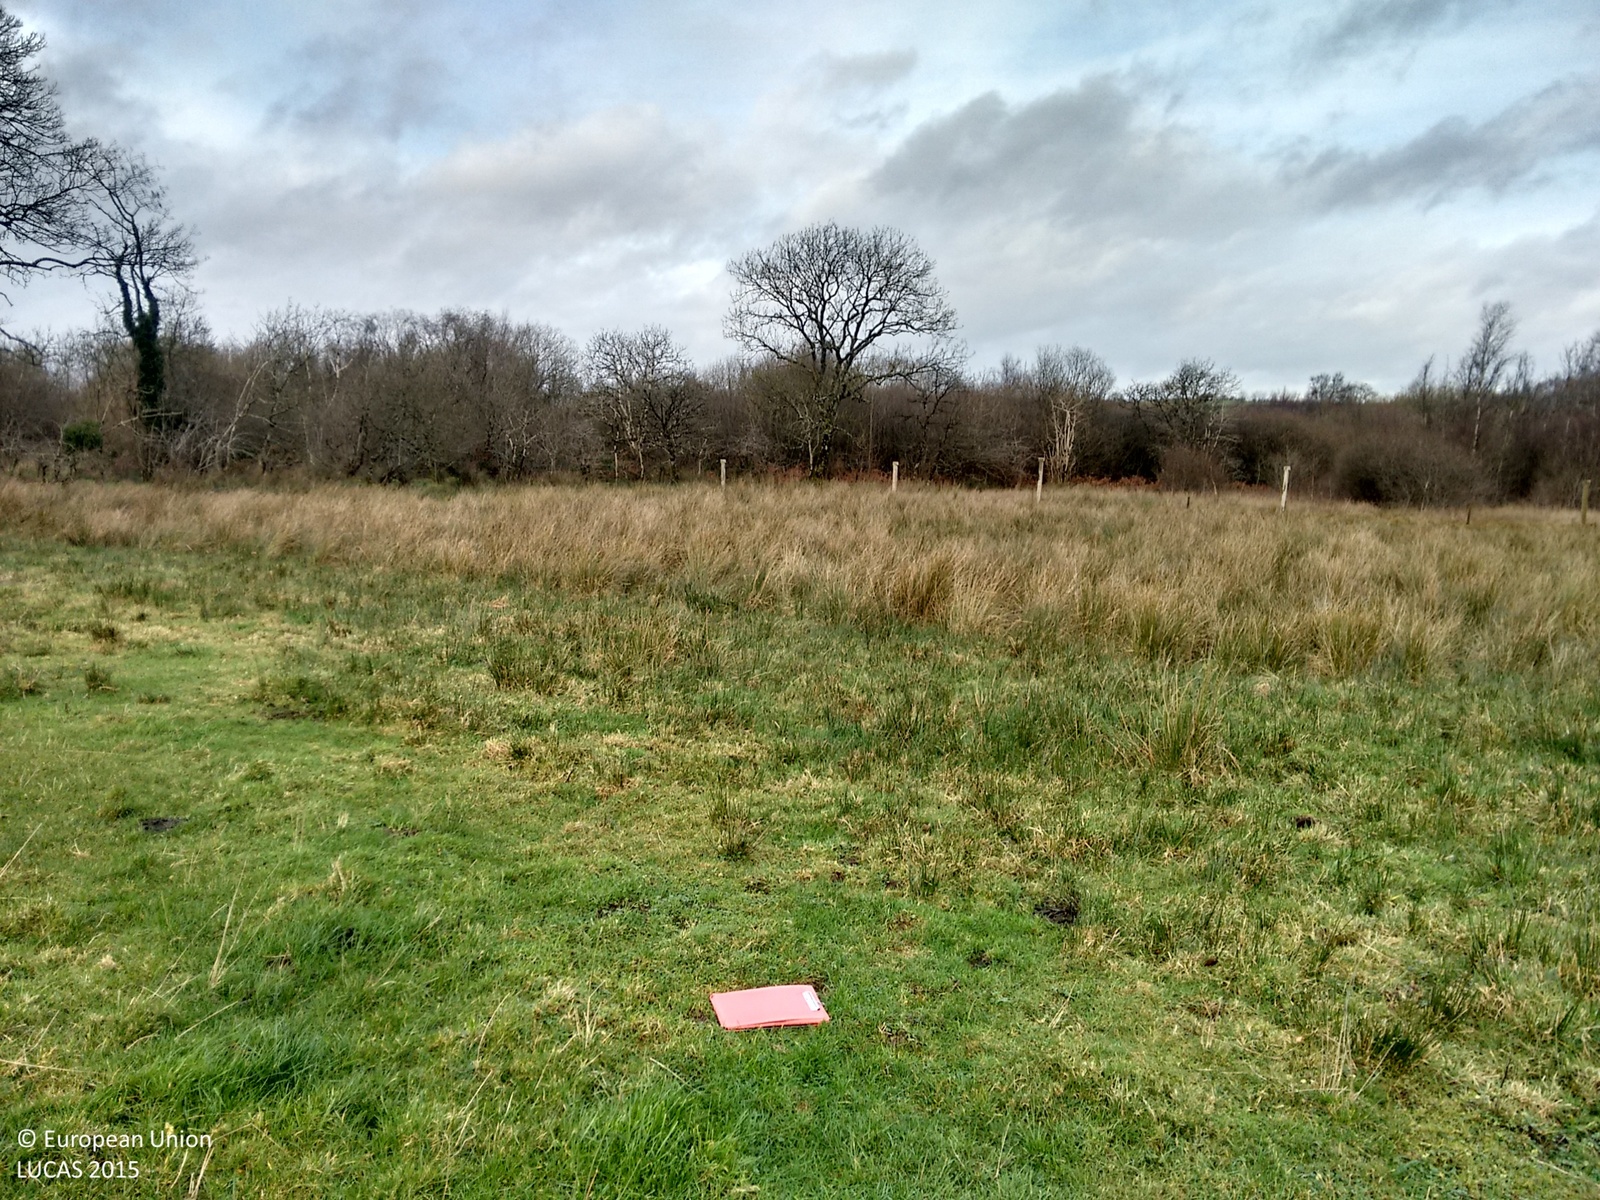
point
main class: Grassland
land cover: Grassland without tree/shrub cover
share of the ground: > 75 %
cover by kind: herbaceous plants 100 %
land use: Agriculture (excluding fallow land and kitchen gardens)
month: December
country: IE
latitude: 53.9690
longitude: -6.8910
